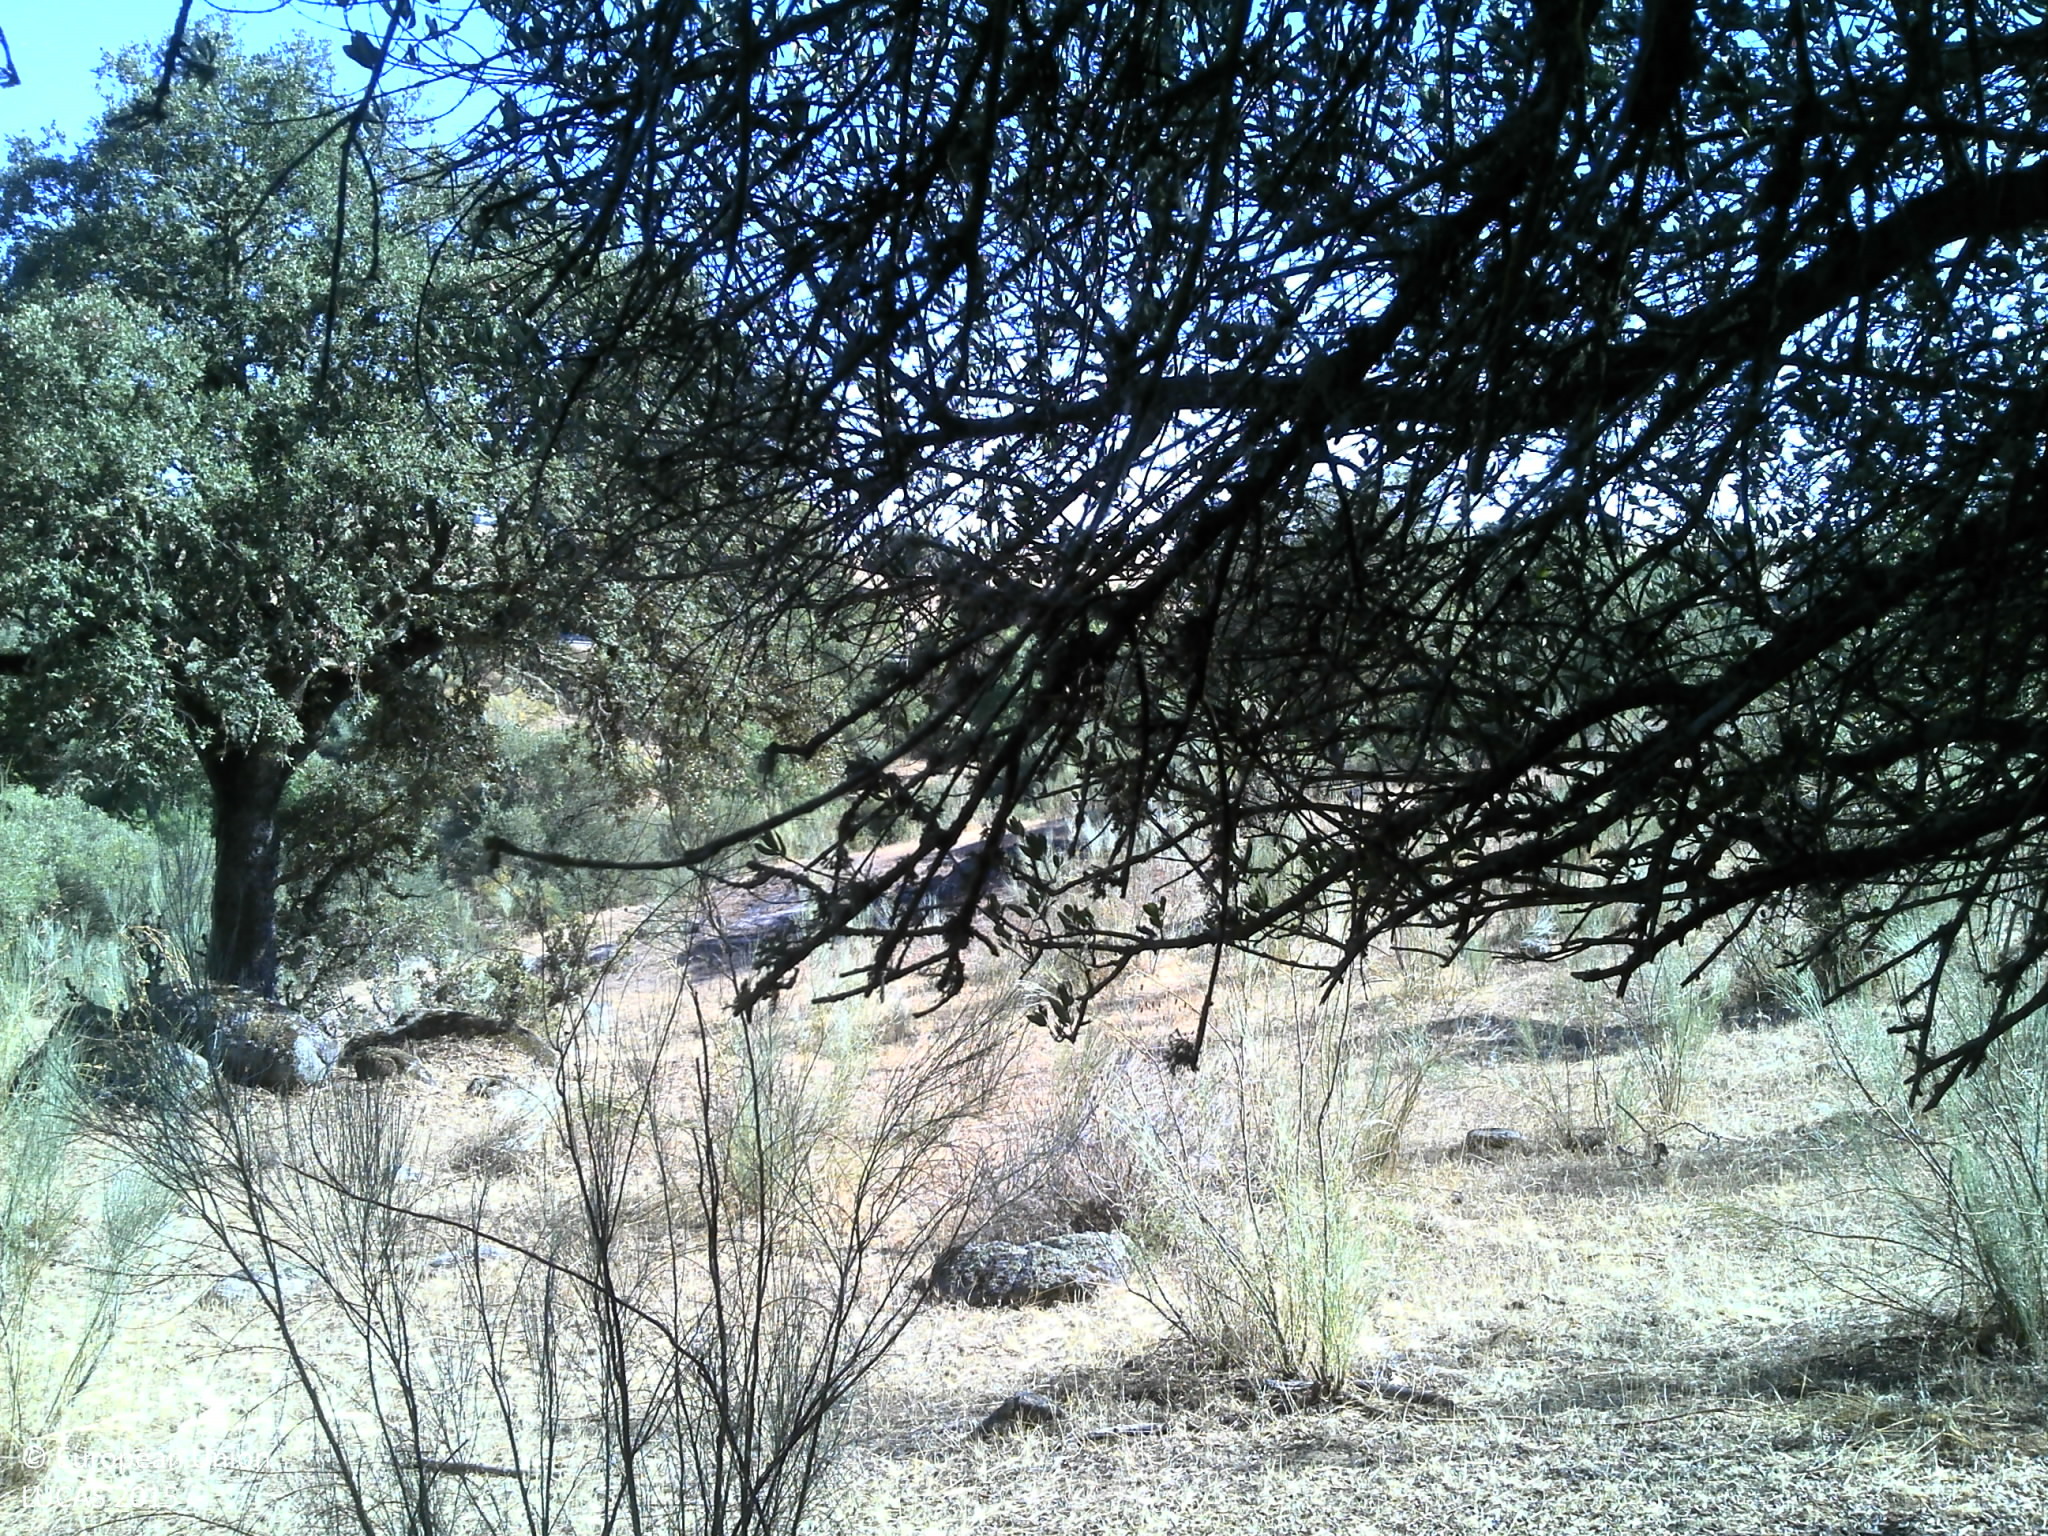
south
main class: Cropland
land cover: Olive groves
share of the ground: 25 - 50 %
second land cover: Shrubland without tree cover
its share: 50 - 75 %
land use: Abandoned areas
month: July
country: PT
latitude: 39.0368
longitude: -7.4708
